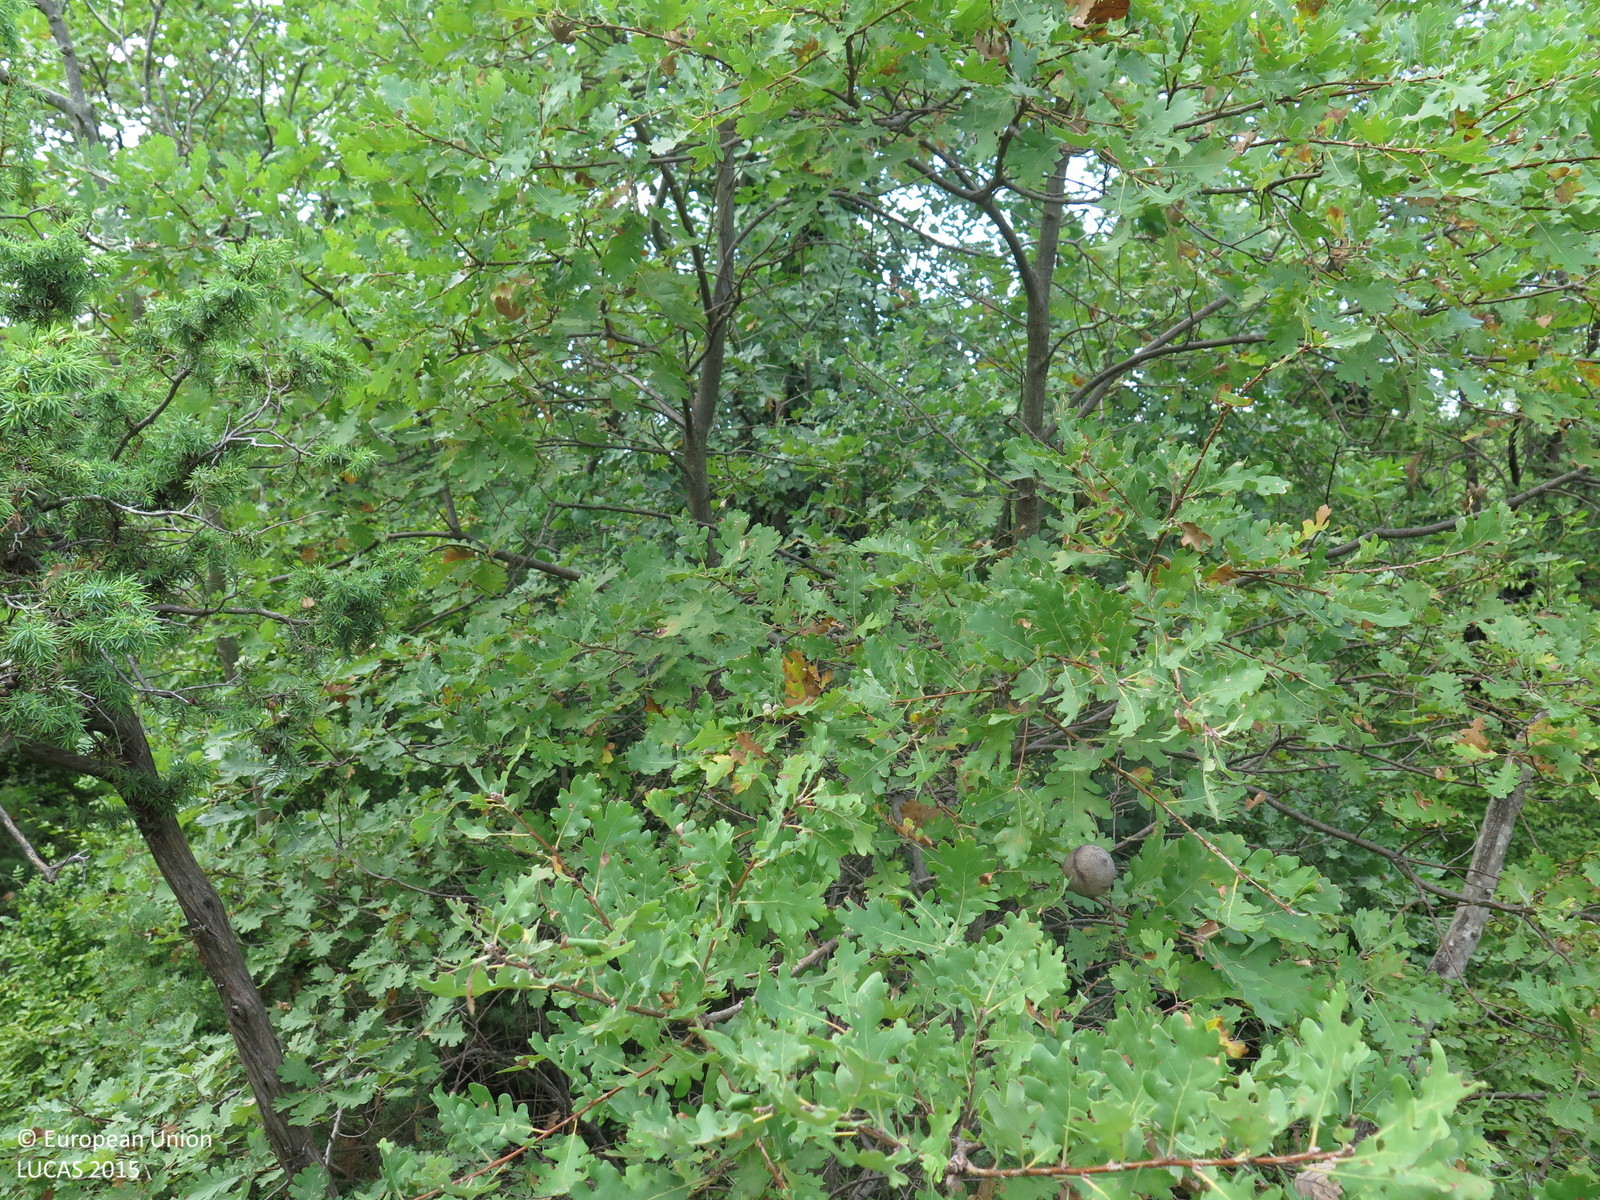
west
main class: Shrubland
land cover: Shrubland with sparse tree cover
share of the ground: > 75 %
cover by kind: shrubs 90 %, broadleaved forest trees 5 %, herbaceous plants 5 %
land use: Semi-natural and natural areas not in use
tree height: < 5 m
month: August
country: HR
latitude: 45.0463
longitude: 14.5268
